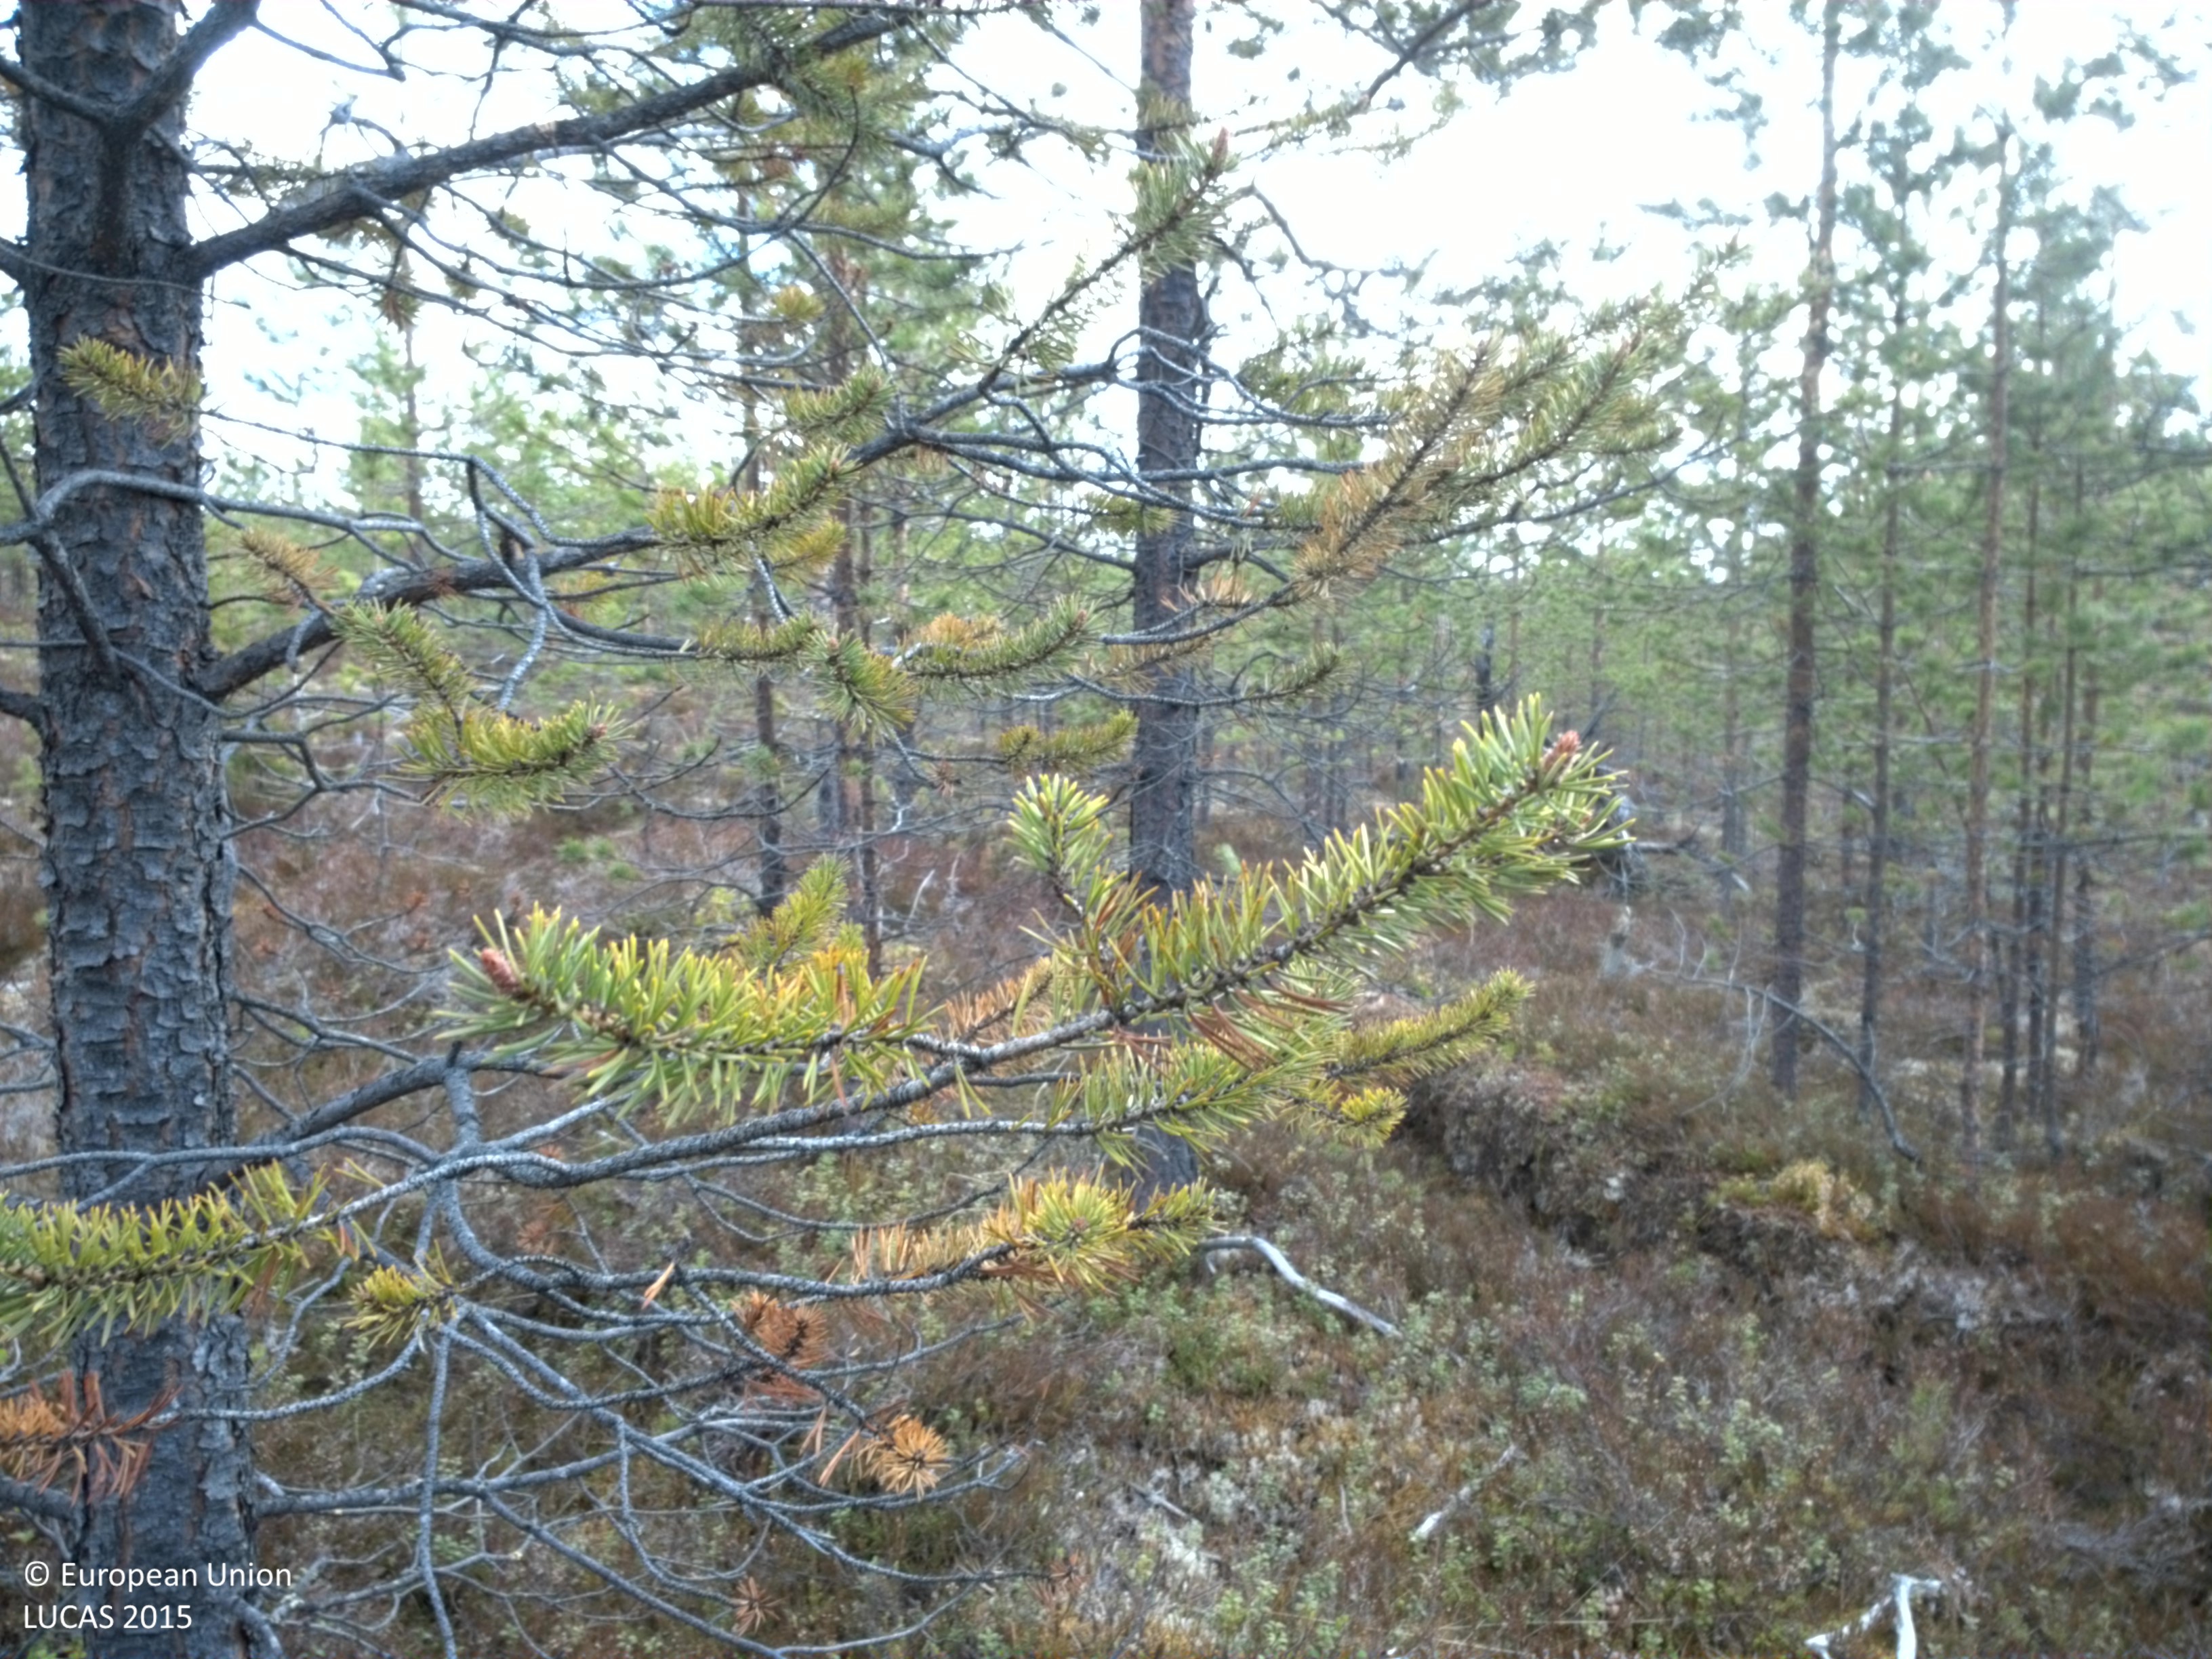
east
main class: Woodland
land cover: Pine dominated coniferous woodland
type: boreal forest
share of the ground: 25 - 50 %
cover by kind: shrubs 55 %, coniferous forest trees 35 %, lichens and mosses 10 %
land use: Forestry
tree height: < 5 m
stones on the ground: < 10 %
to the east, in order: Pine dominated coniferous woodland; Pine dominated mixed woodland
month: June
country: SE
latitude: 66.0970
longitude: 19.2230
